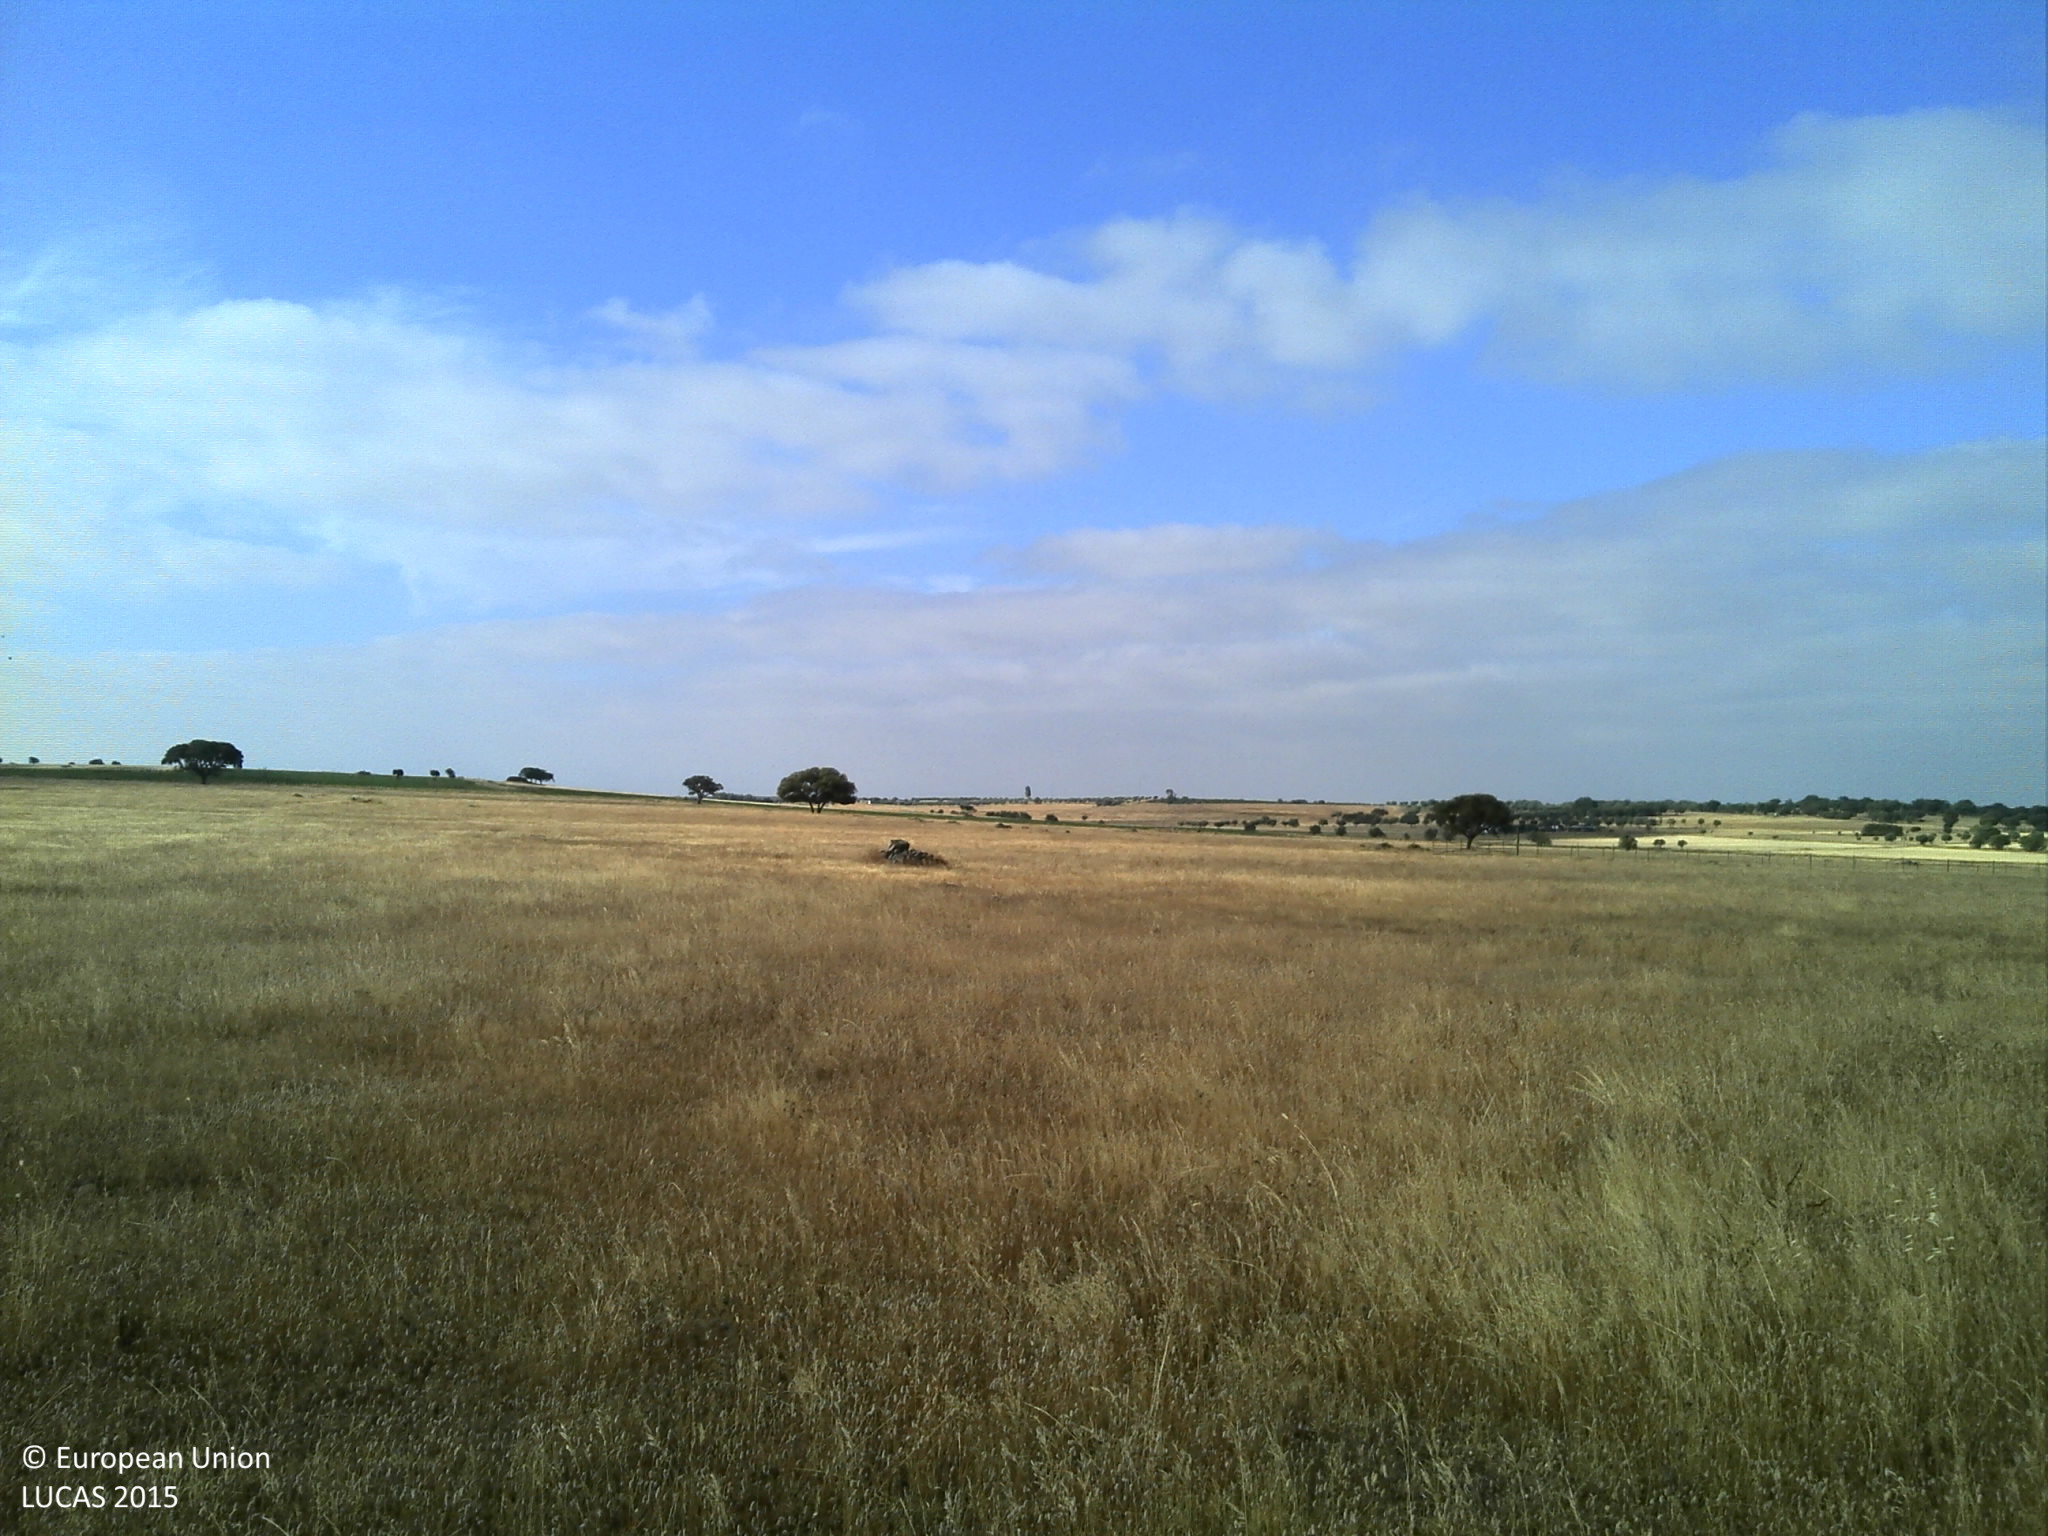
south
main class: Grassland
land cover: Grassland without tree/shrub cover
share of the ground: > 75 %
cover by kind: herbaceous plants 80 %, unconsolidated bare surface 20 %
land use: Agriculture (excluding fallow land and kitchen gardens)
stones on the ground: < 10 %
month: June
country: PT
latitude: 38.1769
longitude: -7.9202
